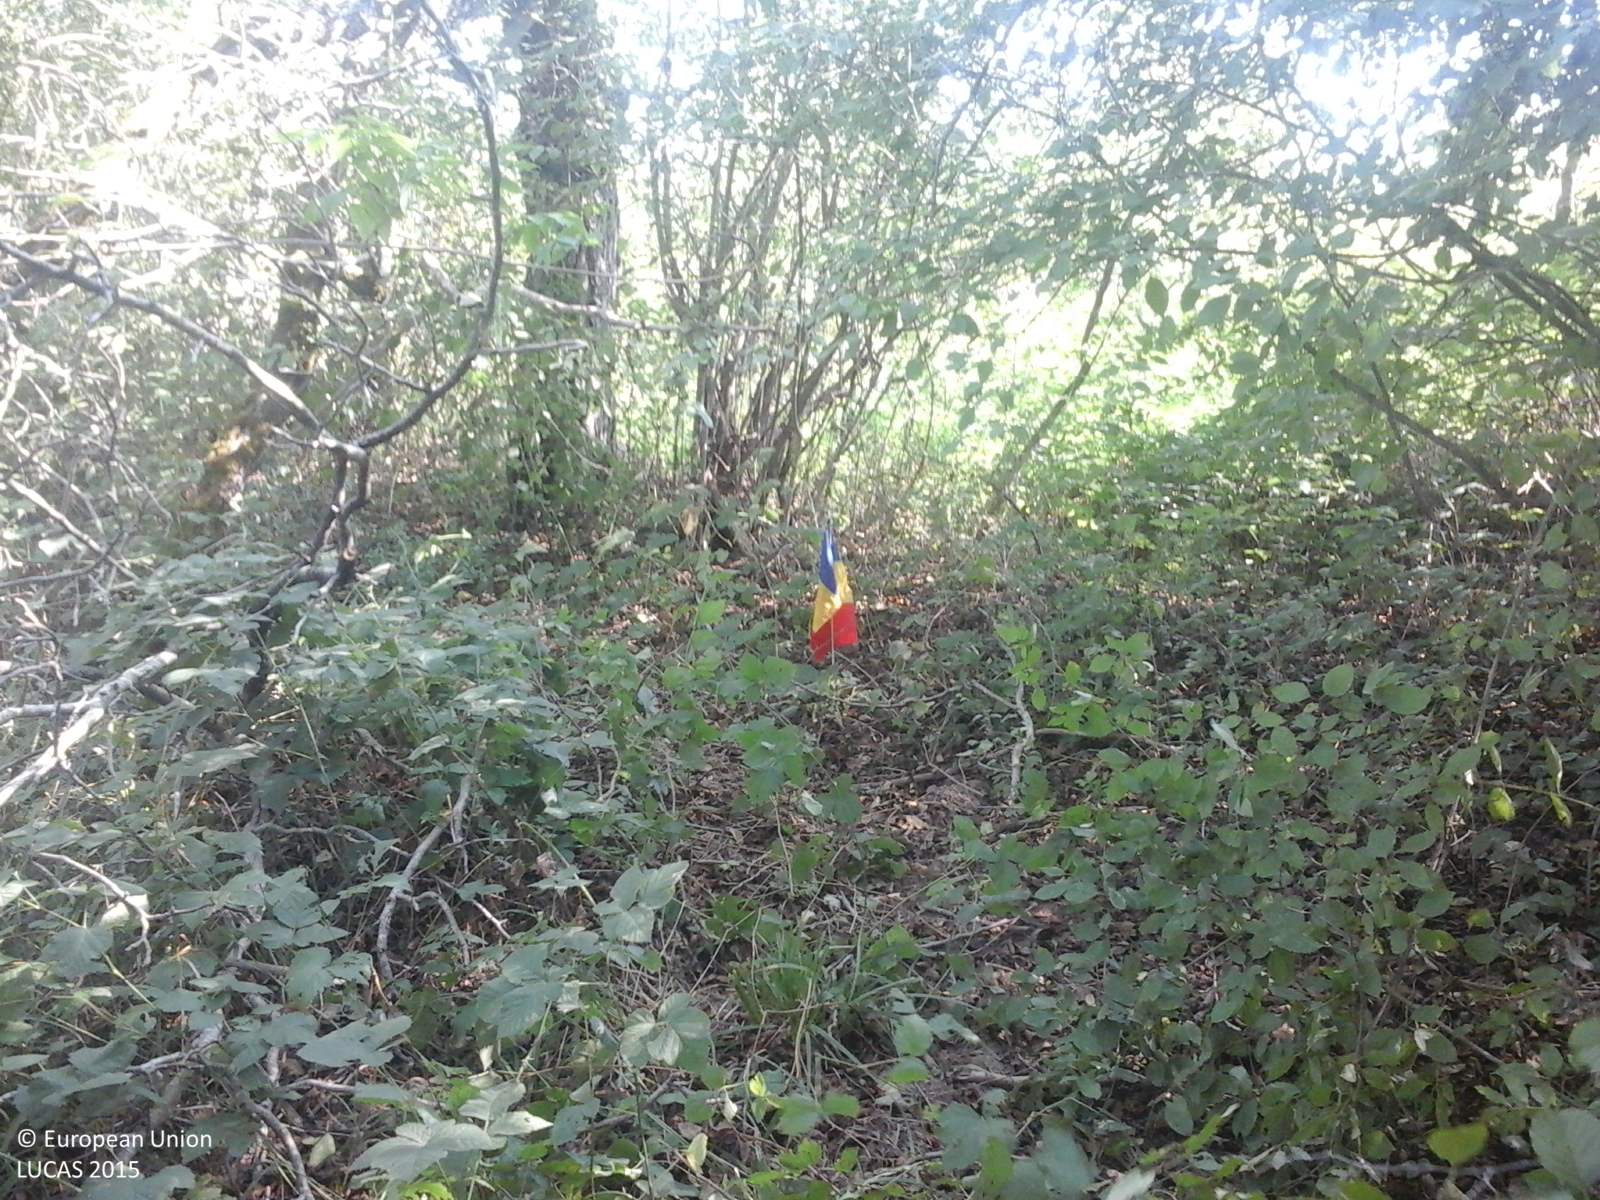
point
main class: Woodland
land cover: Broadleaved woodland
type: non-riverine alder, birch or aspen forest
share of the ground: > 75 %
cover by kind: broadleaved forest trees 100 %
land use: Forestry
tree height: > 5 m
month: August
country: RO
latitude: 46.4311
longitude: 22.2148
